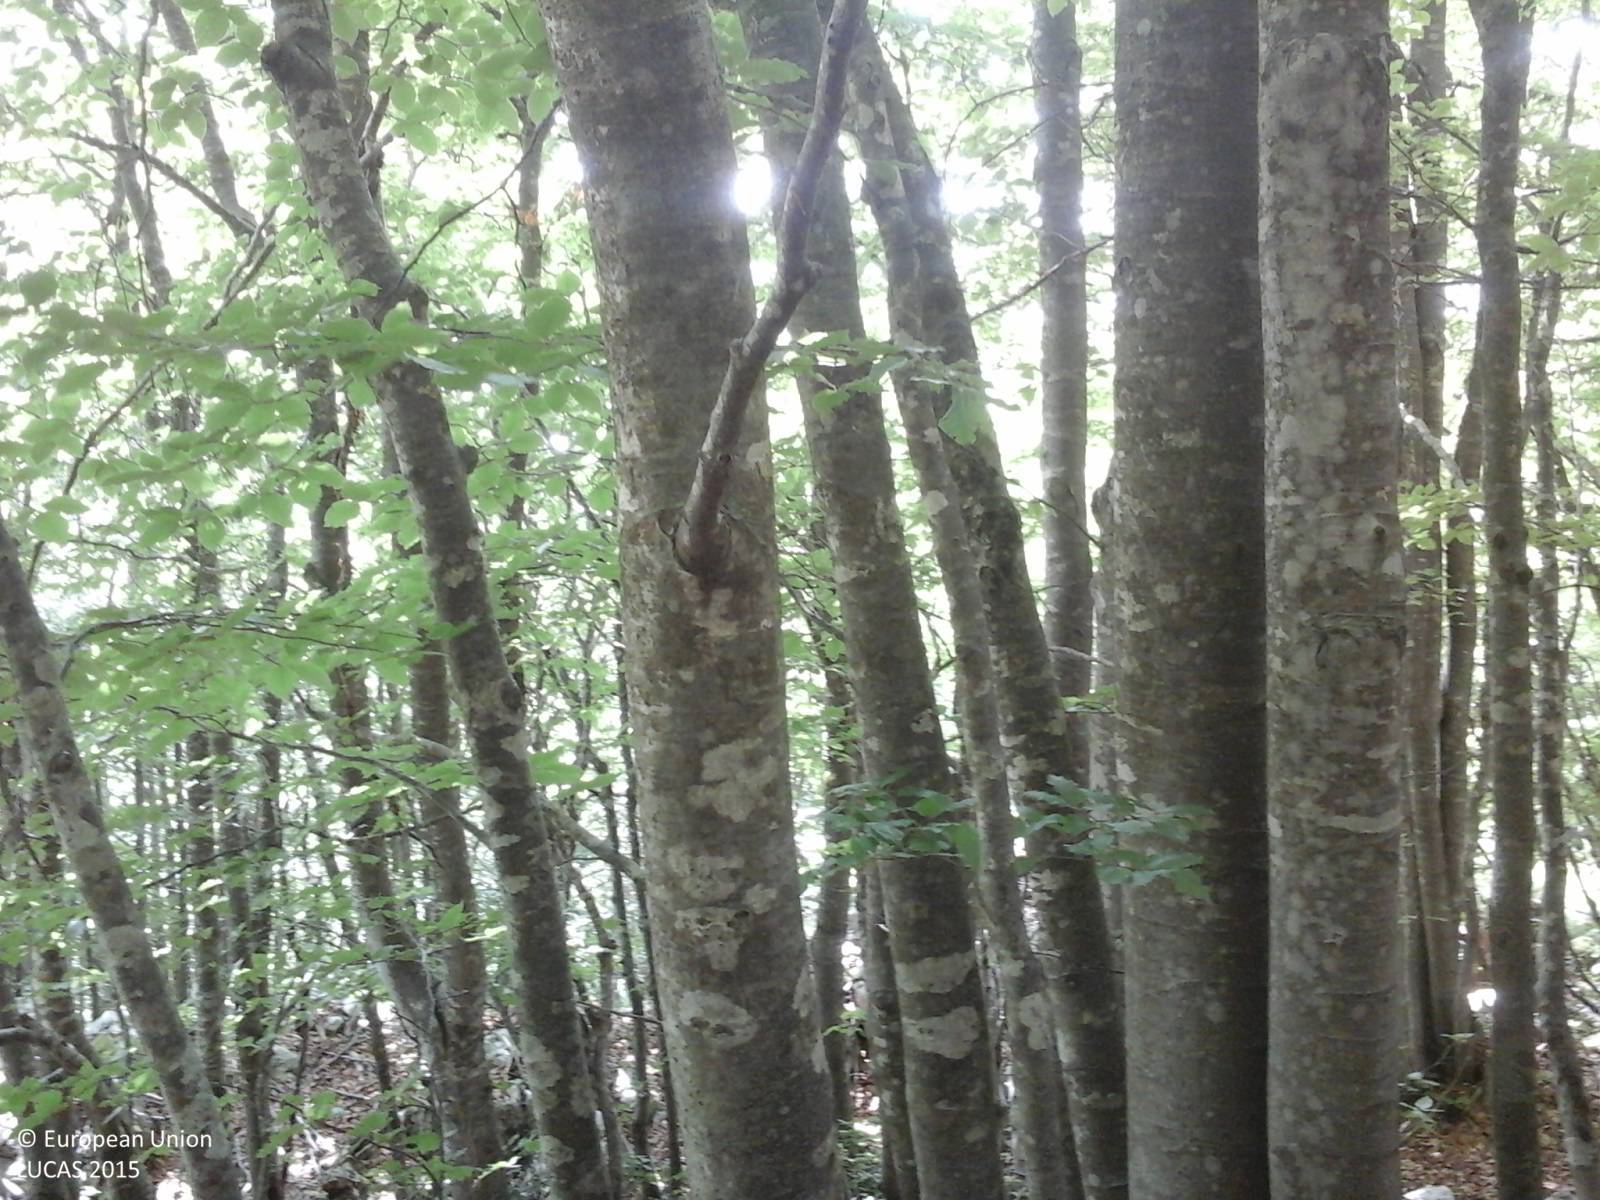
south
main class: Woodland
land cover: Broadleaved woodland
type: mountainous beech forest
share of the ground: > 75 %
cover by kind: broadleaved forest trees 100 %
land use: Forestry
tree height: > 5 m
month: July
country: IT
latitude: 46.1227
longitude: 12.5463
